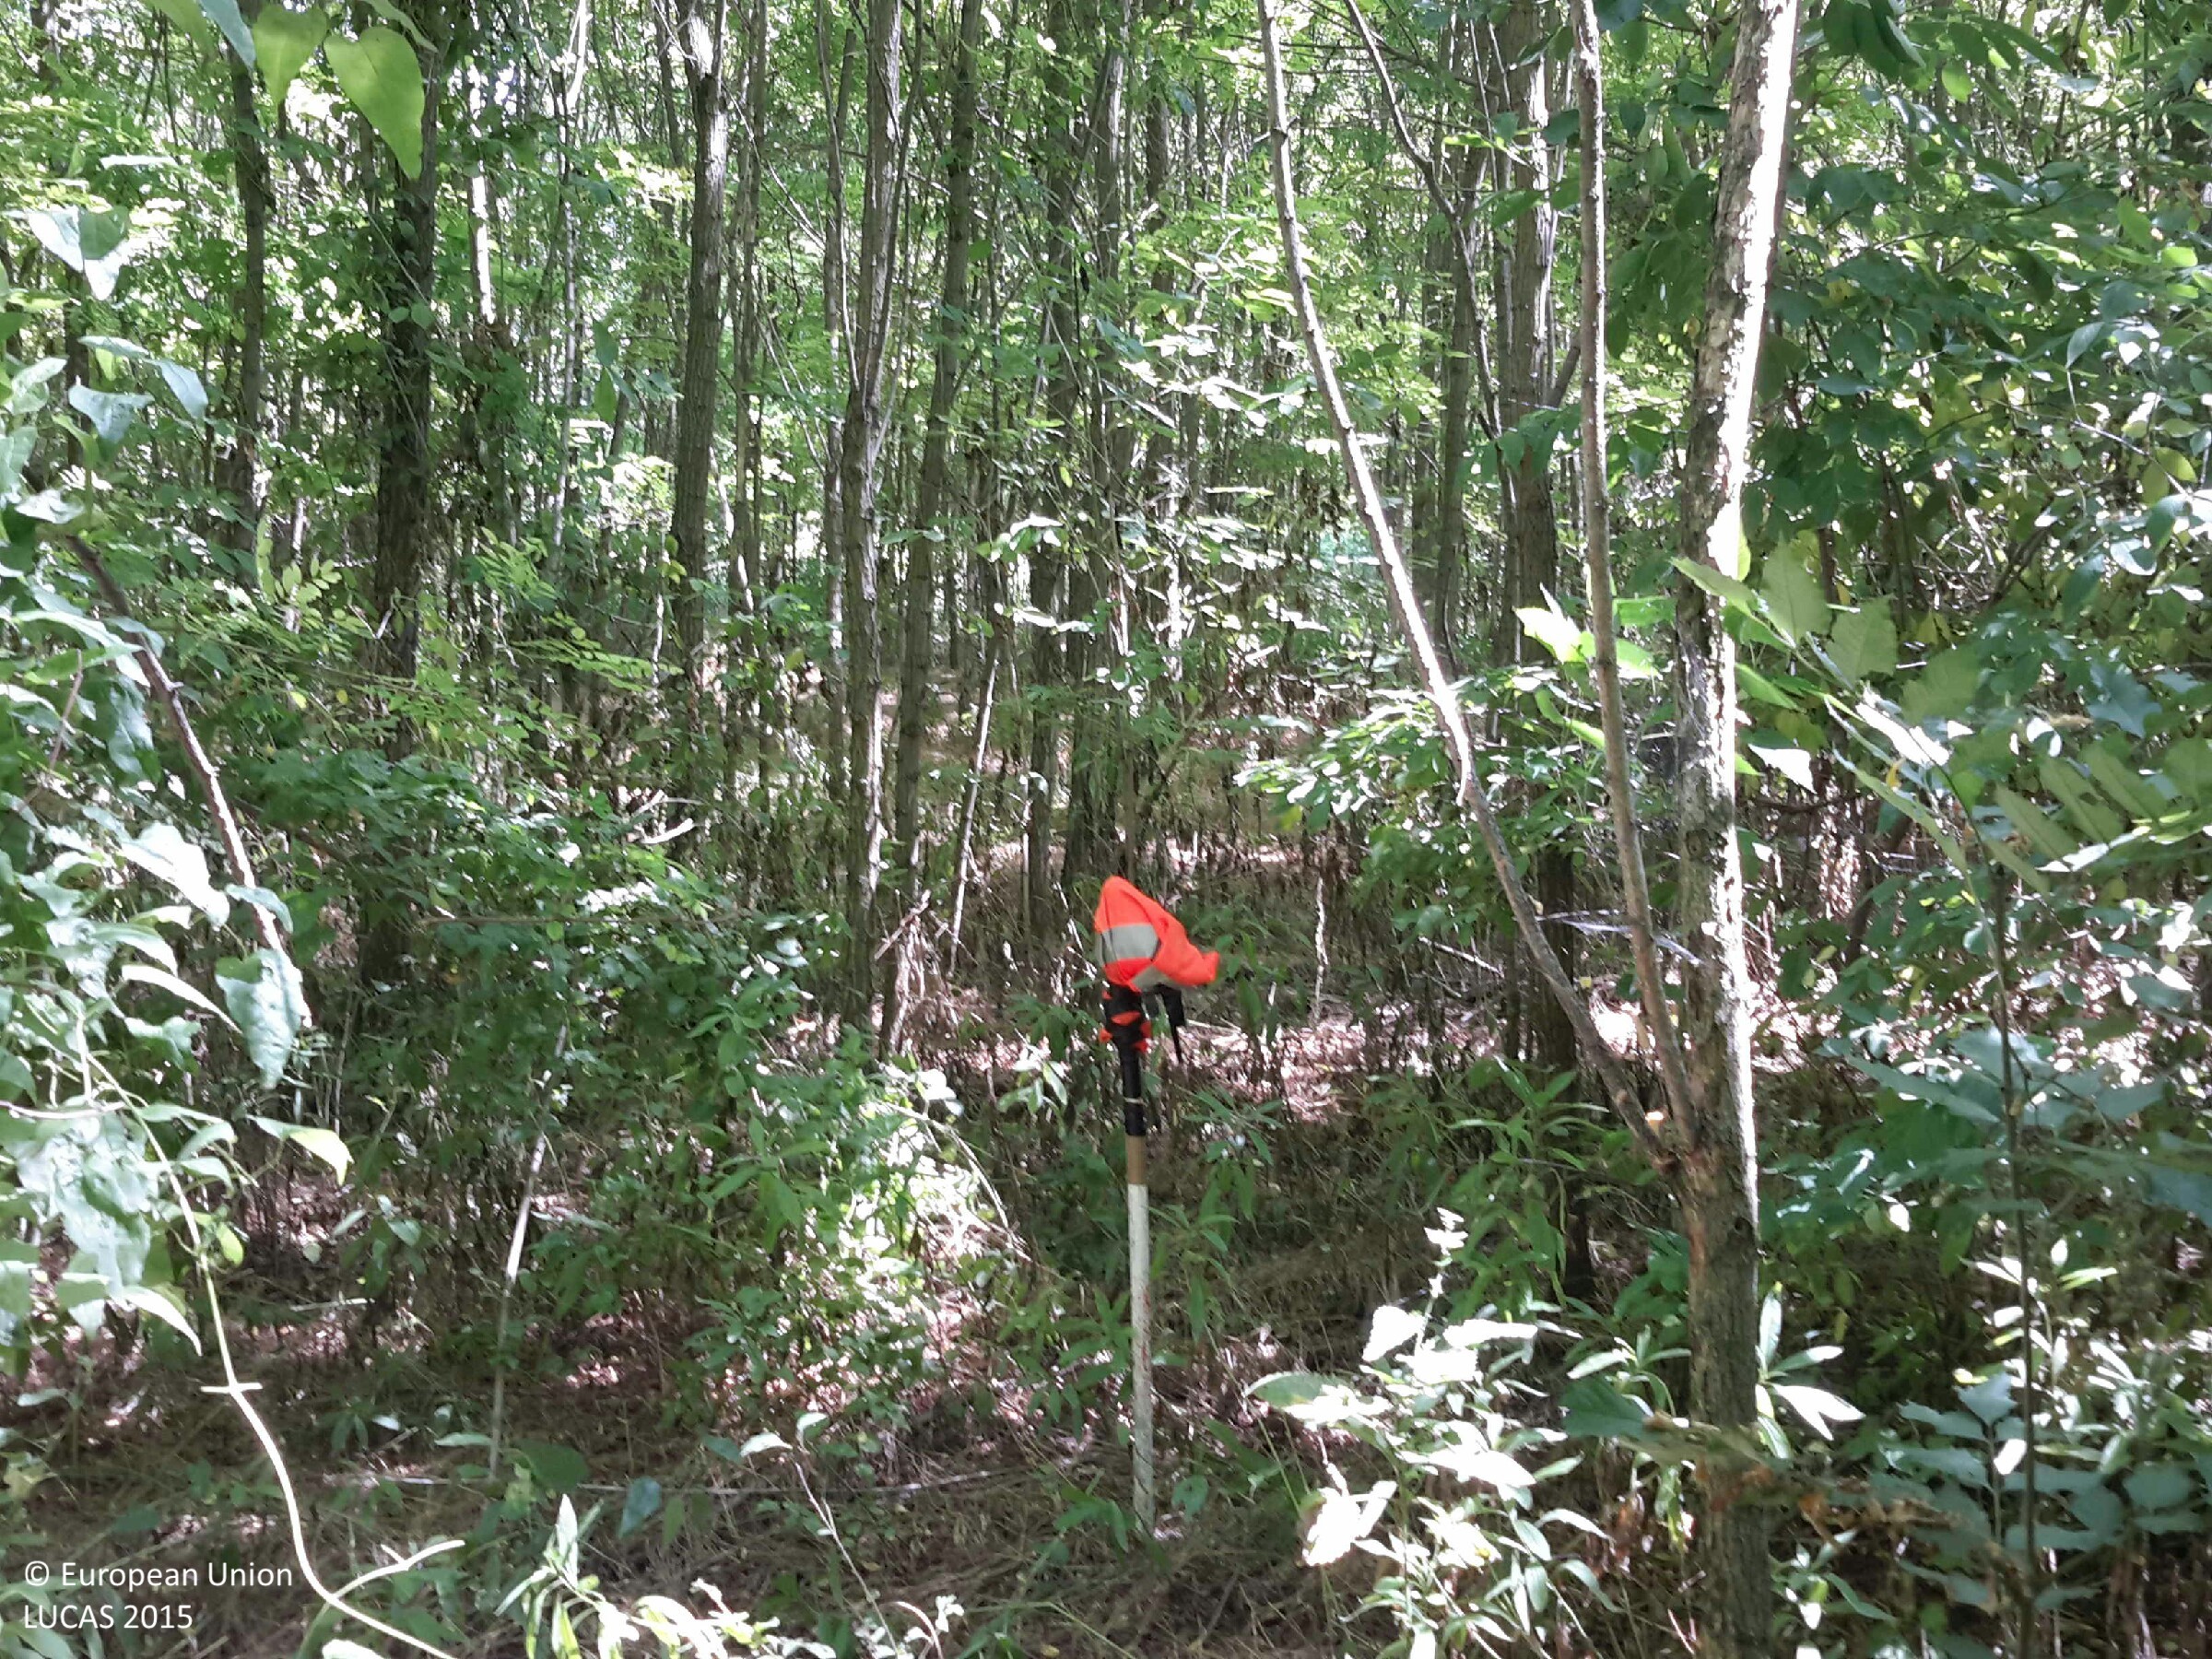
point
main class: Woodland
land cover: Broadleaved woodland
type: exotic forest
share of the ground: > 75 %
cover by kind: broadleaved forest trees 90 %, herbaceous plants 10 %
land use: Forestry
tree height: > 5 m
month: July
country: HU
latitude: 47.7640
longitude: 17.5741
